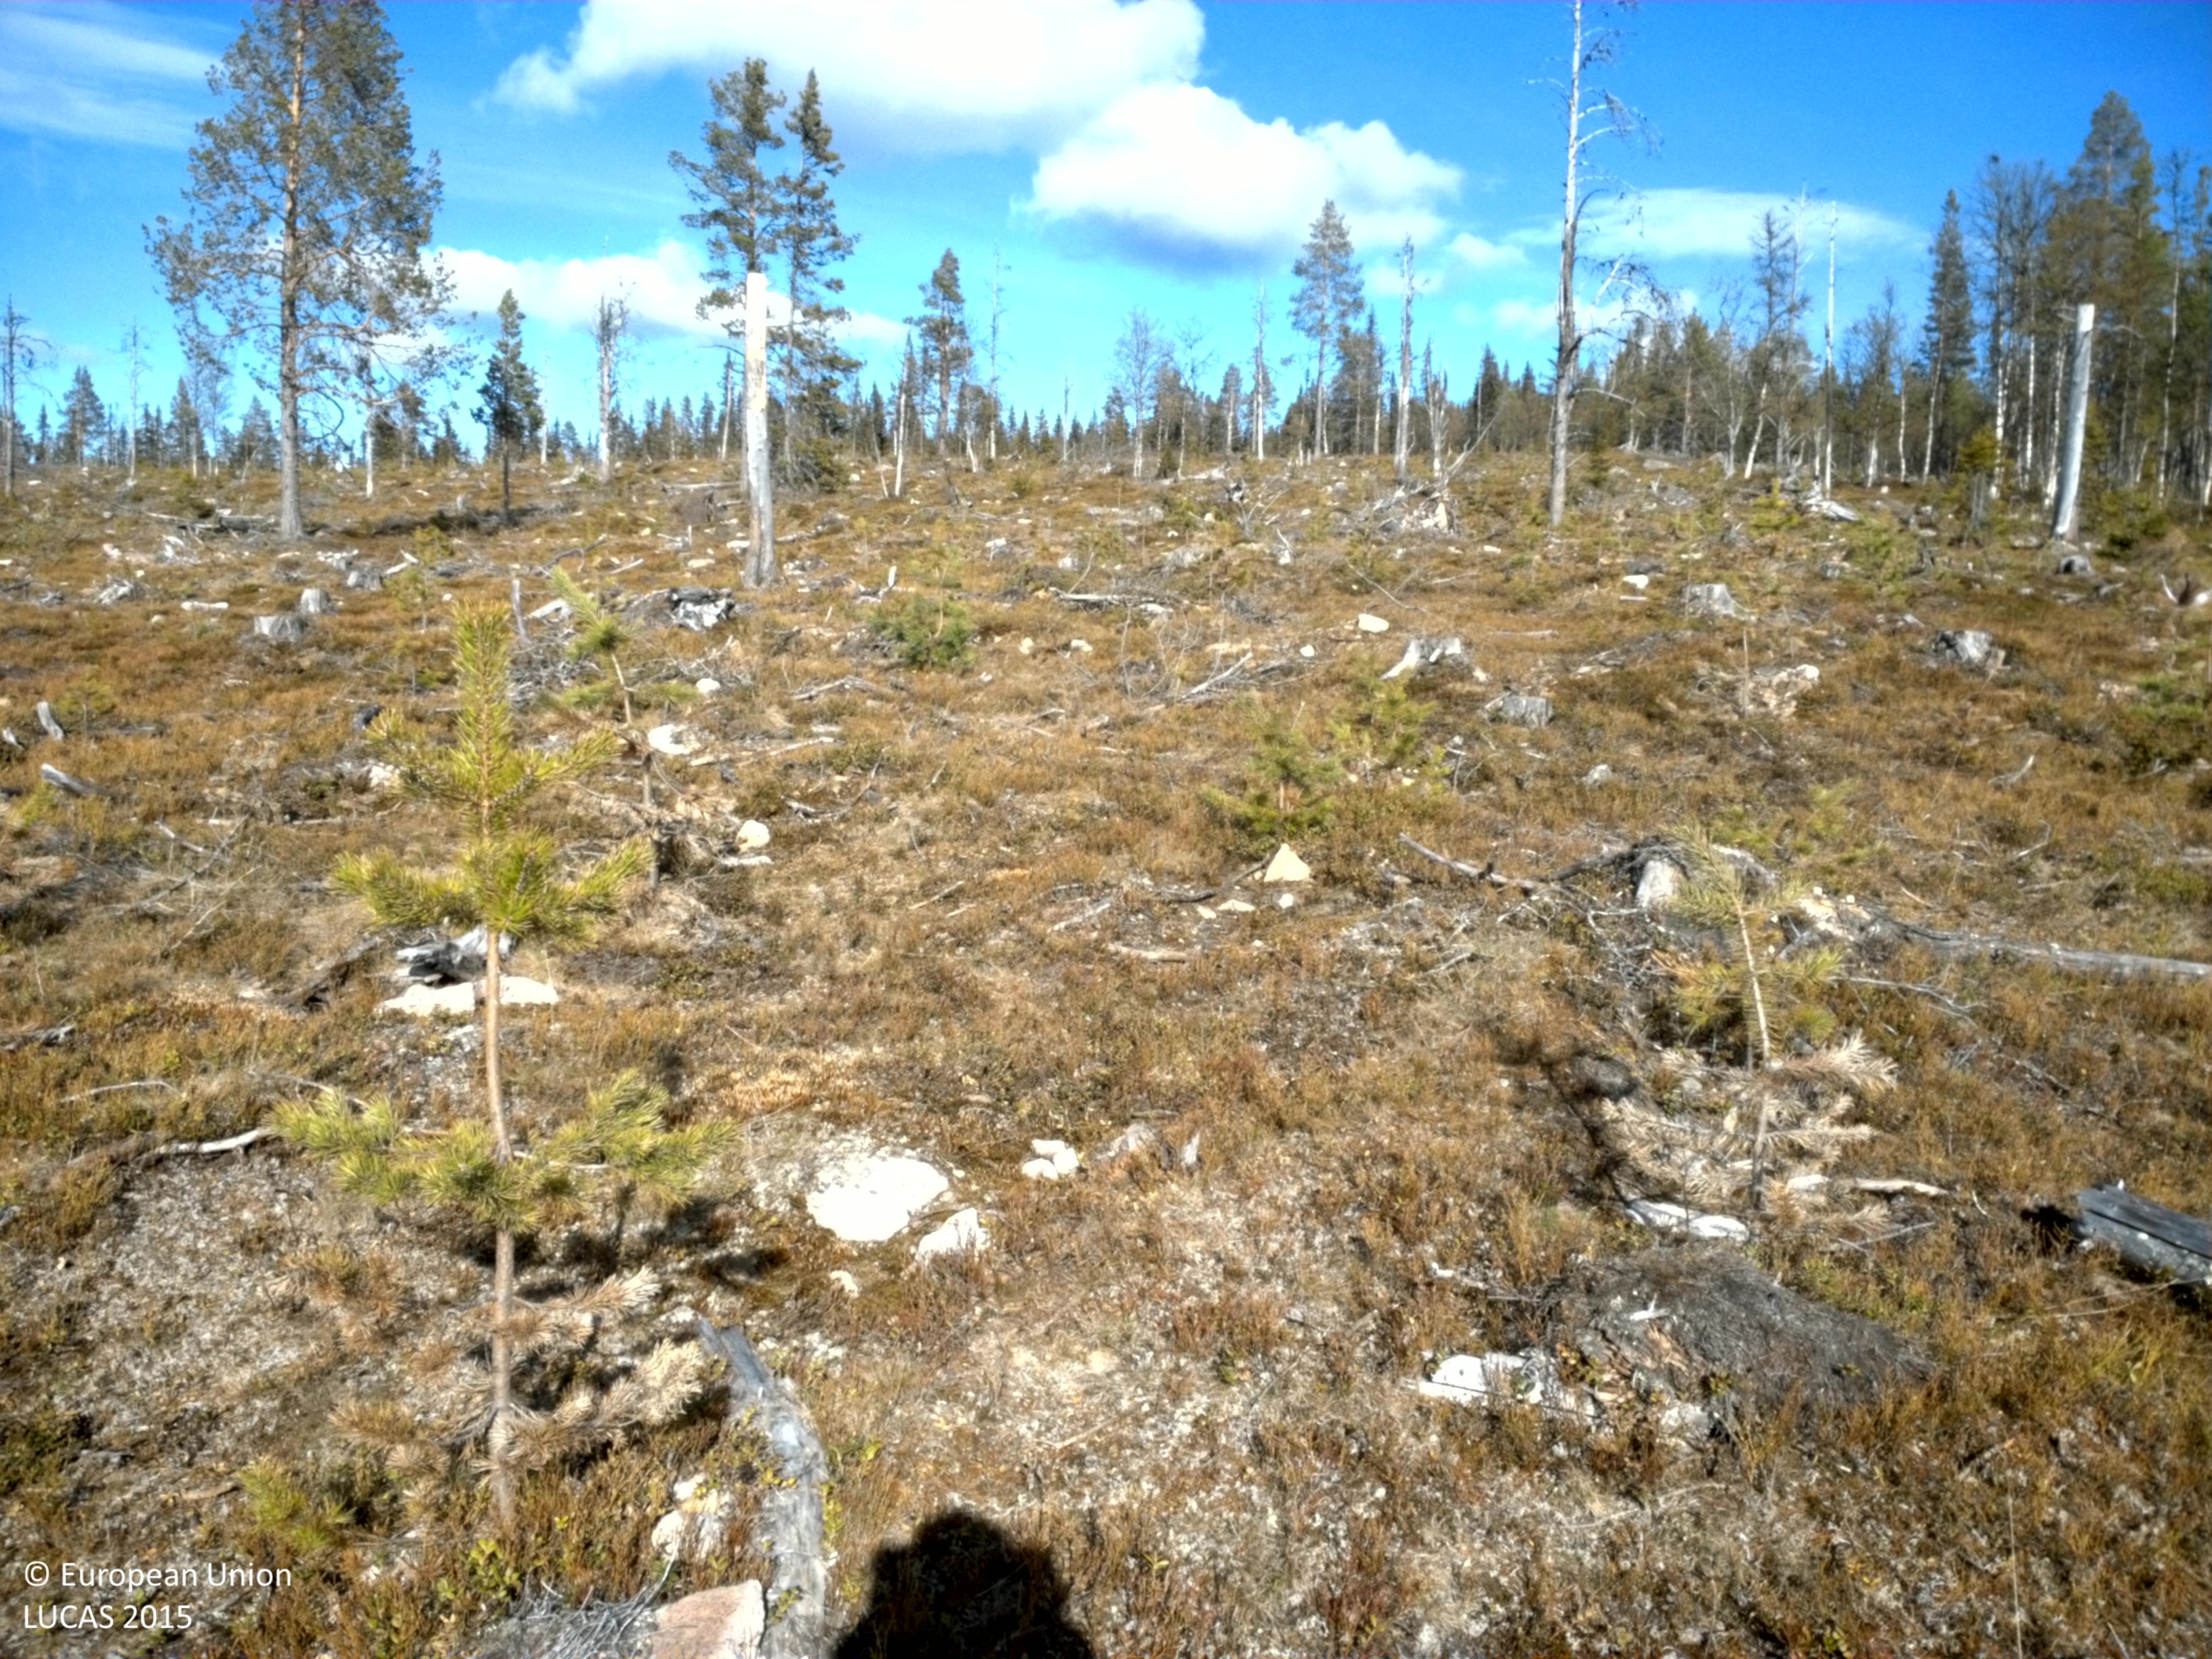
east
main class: Shrubland
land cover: Shrubland with sparse tree cover
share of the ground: > 75 %
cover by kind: shrubs 90 %, coniferous forest trees 5 %, consolidated bare surface 5 %
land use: Forestry
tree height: < 5 m
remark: Clear cut
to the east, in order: Shrubland with sparse tree cover; Spruce dominated coniferous woodland
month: June
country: SE
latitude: 66.3821
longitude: 18.2956
